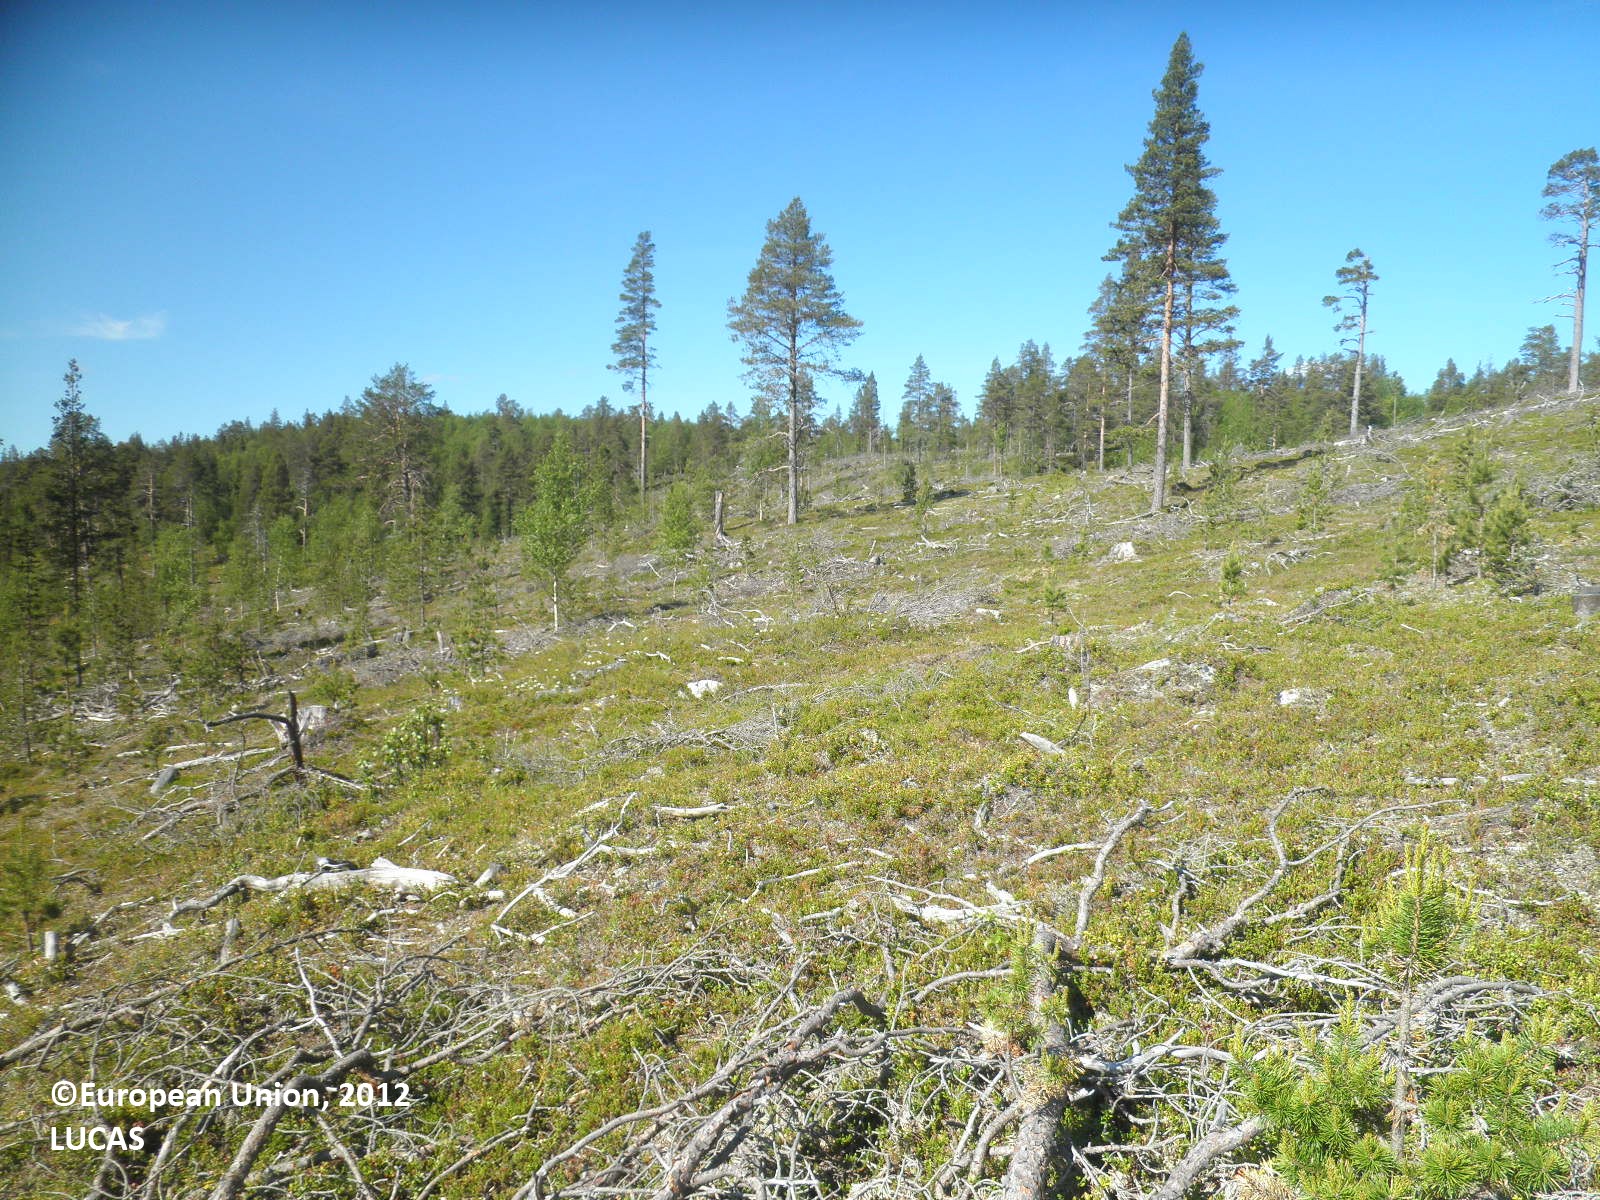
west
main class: Shrubland
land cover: Shrubland with sparse tree cover
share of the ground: 50 - 75 %
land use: Forestry
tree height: < 5 m
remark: Clear cut
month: July
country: FI
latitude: 68.7971
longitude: 26.6271
